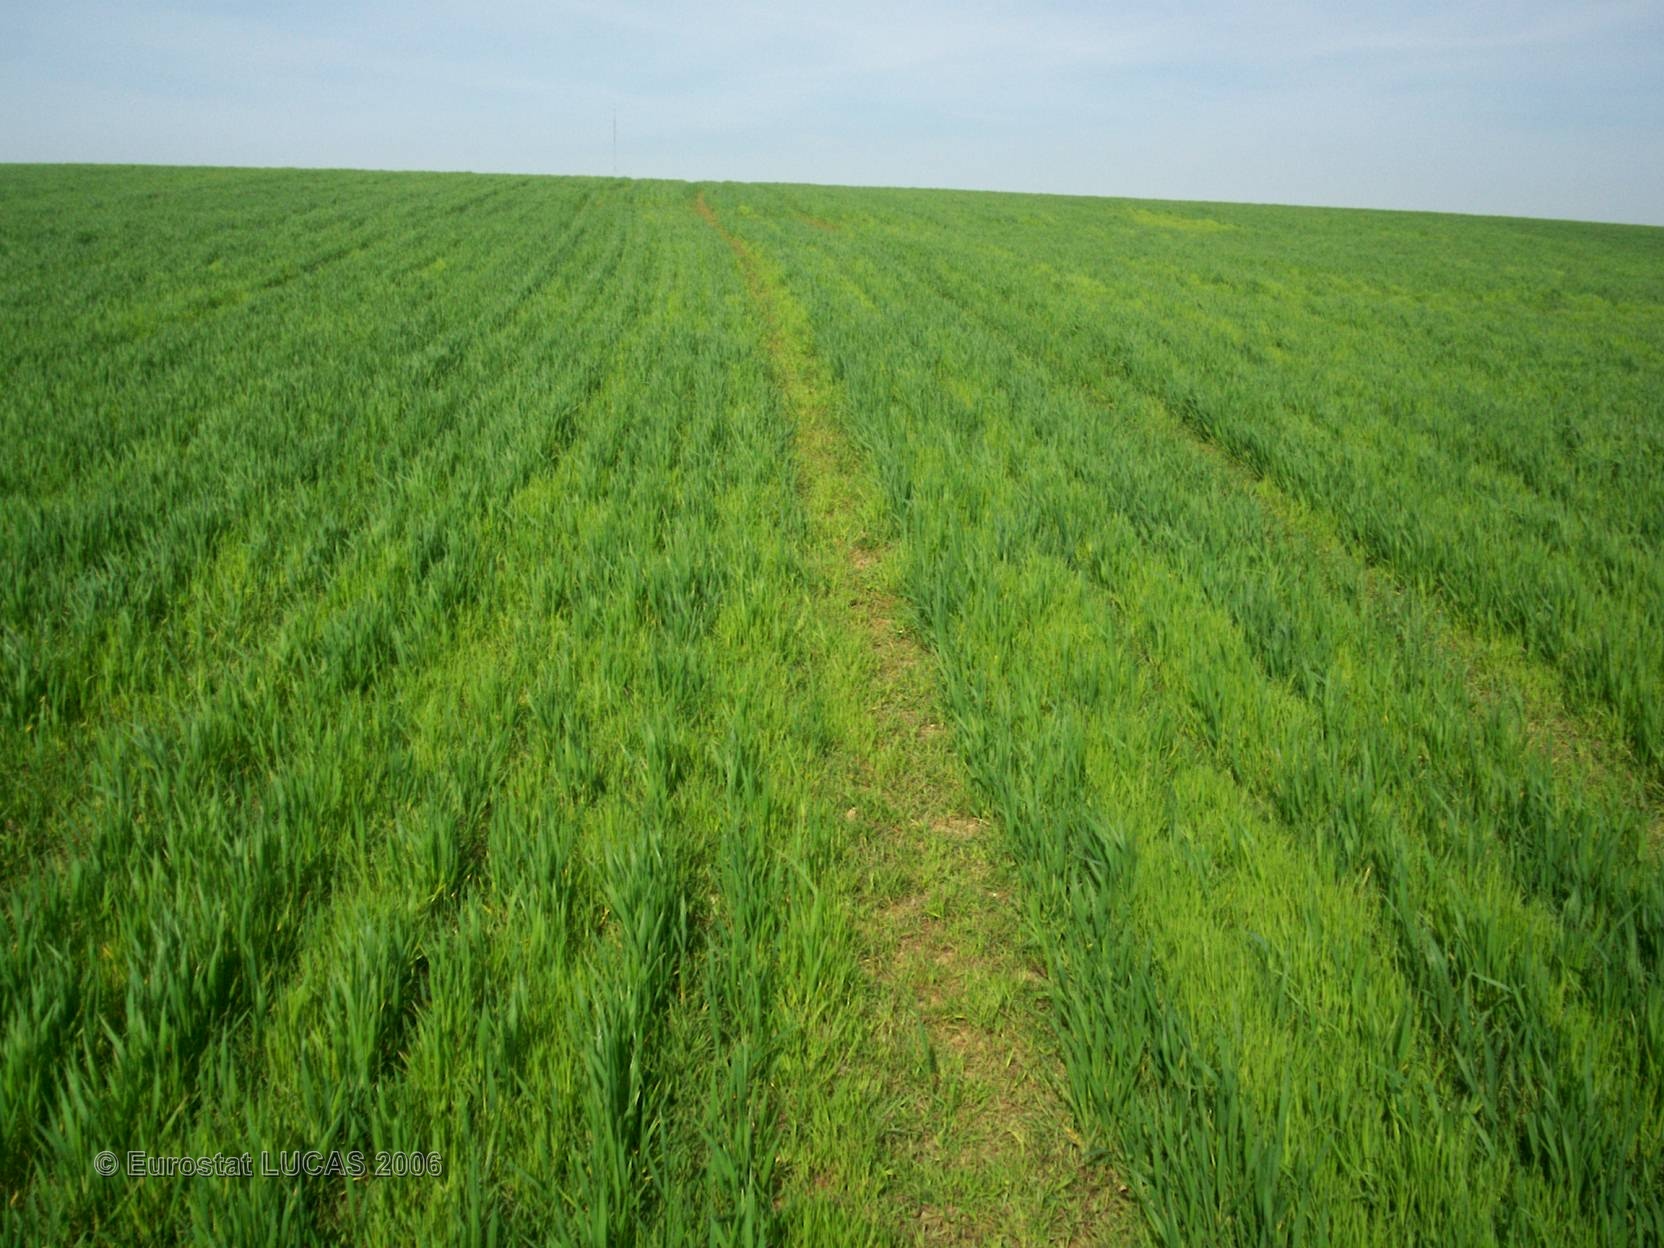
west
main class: Cropland
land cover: Common wheat
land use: Agriculture (excluding fallow land and kitchen gardens)
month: May
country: FR
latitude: 49.1774
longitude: 6.5294
